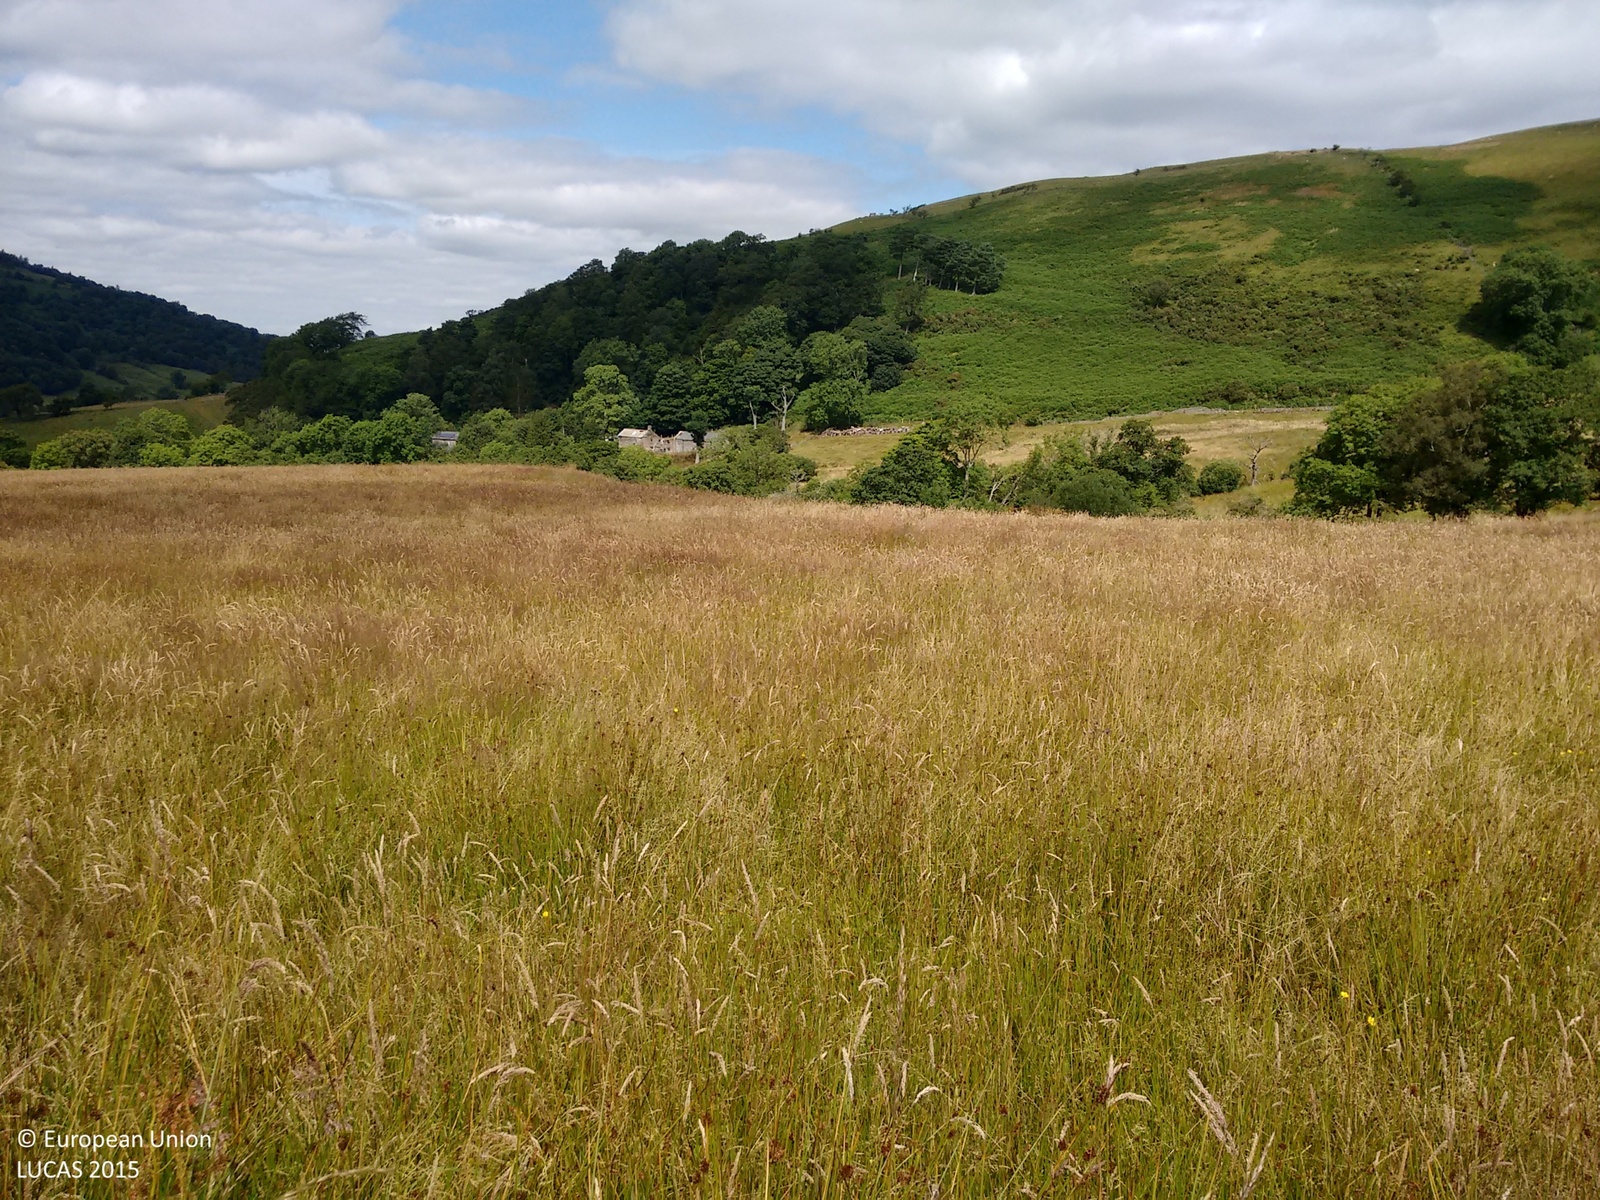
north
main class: Grassland
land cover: Grassland without tree/shrub cover
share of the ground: > 75 %
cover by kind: herbaceous plants 100 %
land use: Agriculture (excluding fallow land and kitchen gardens)
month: August
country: GB
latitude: 54.6030
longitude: -2.9037
